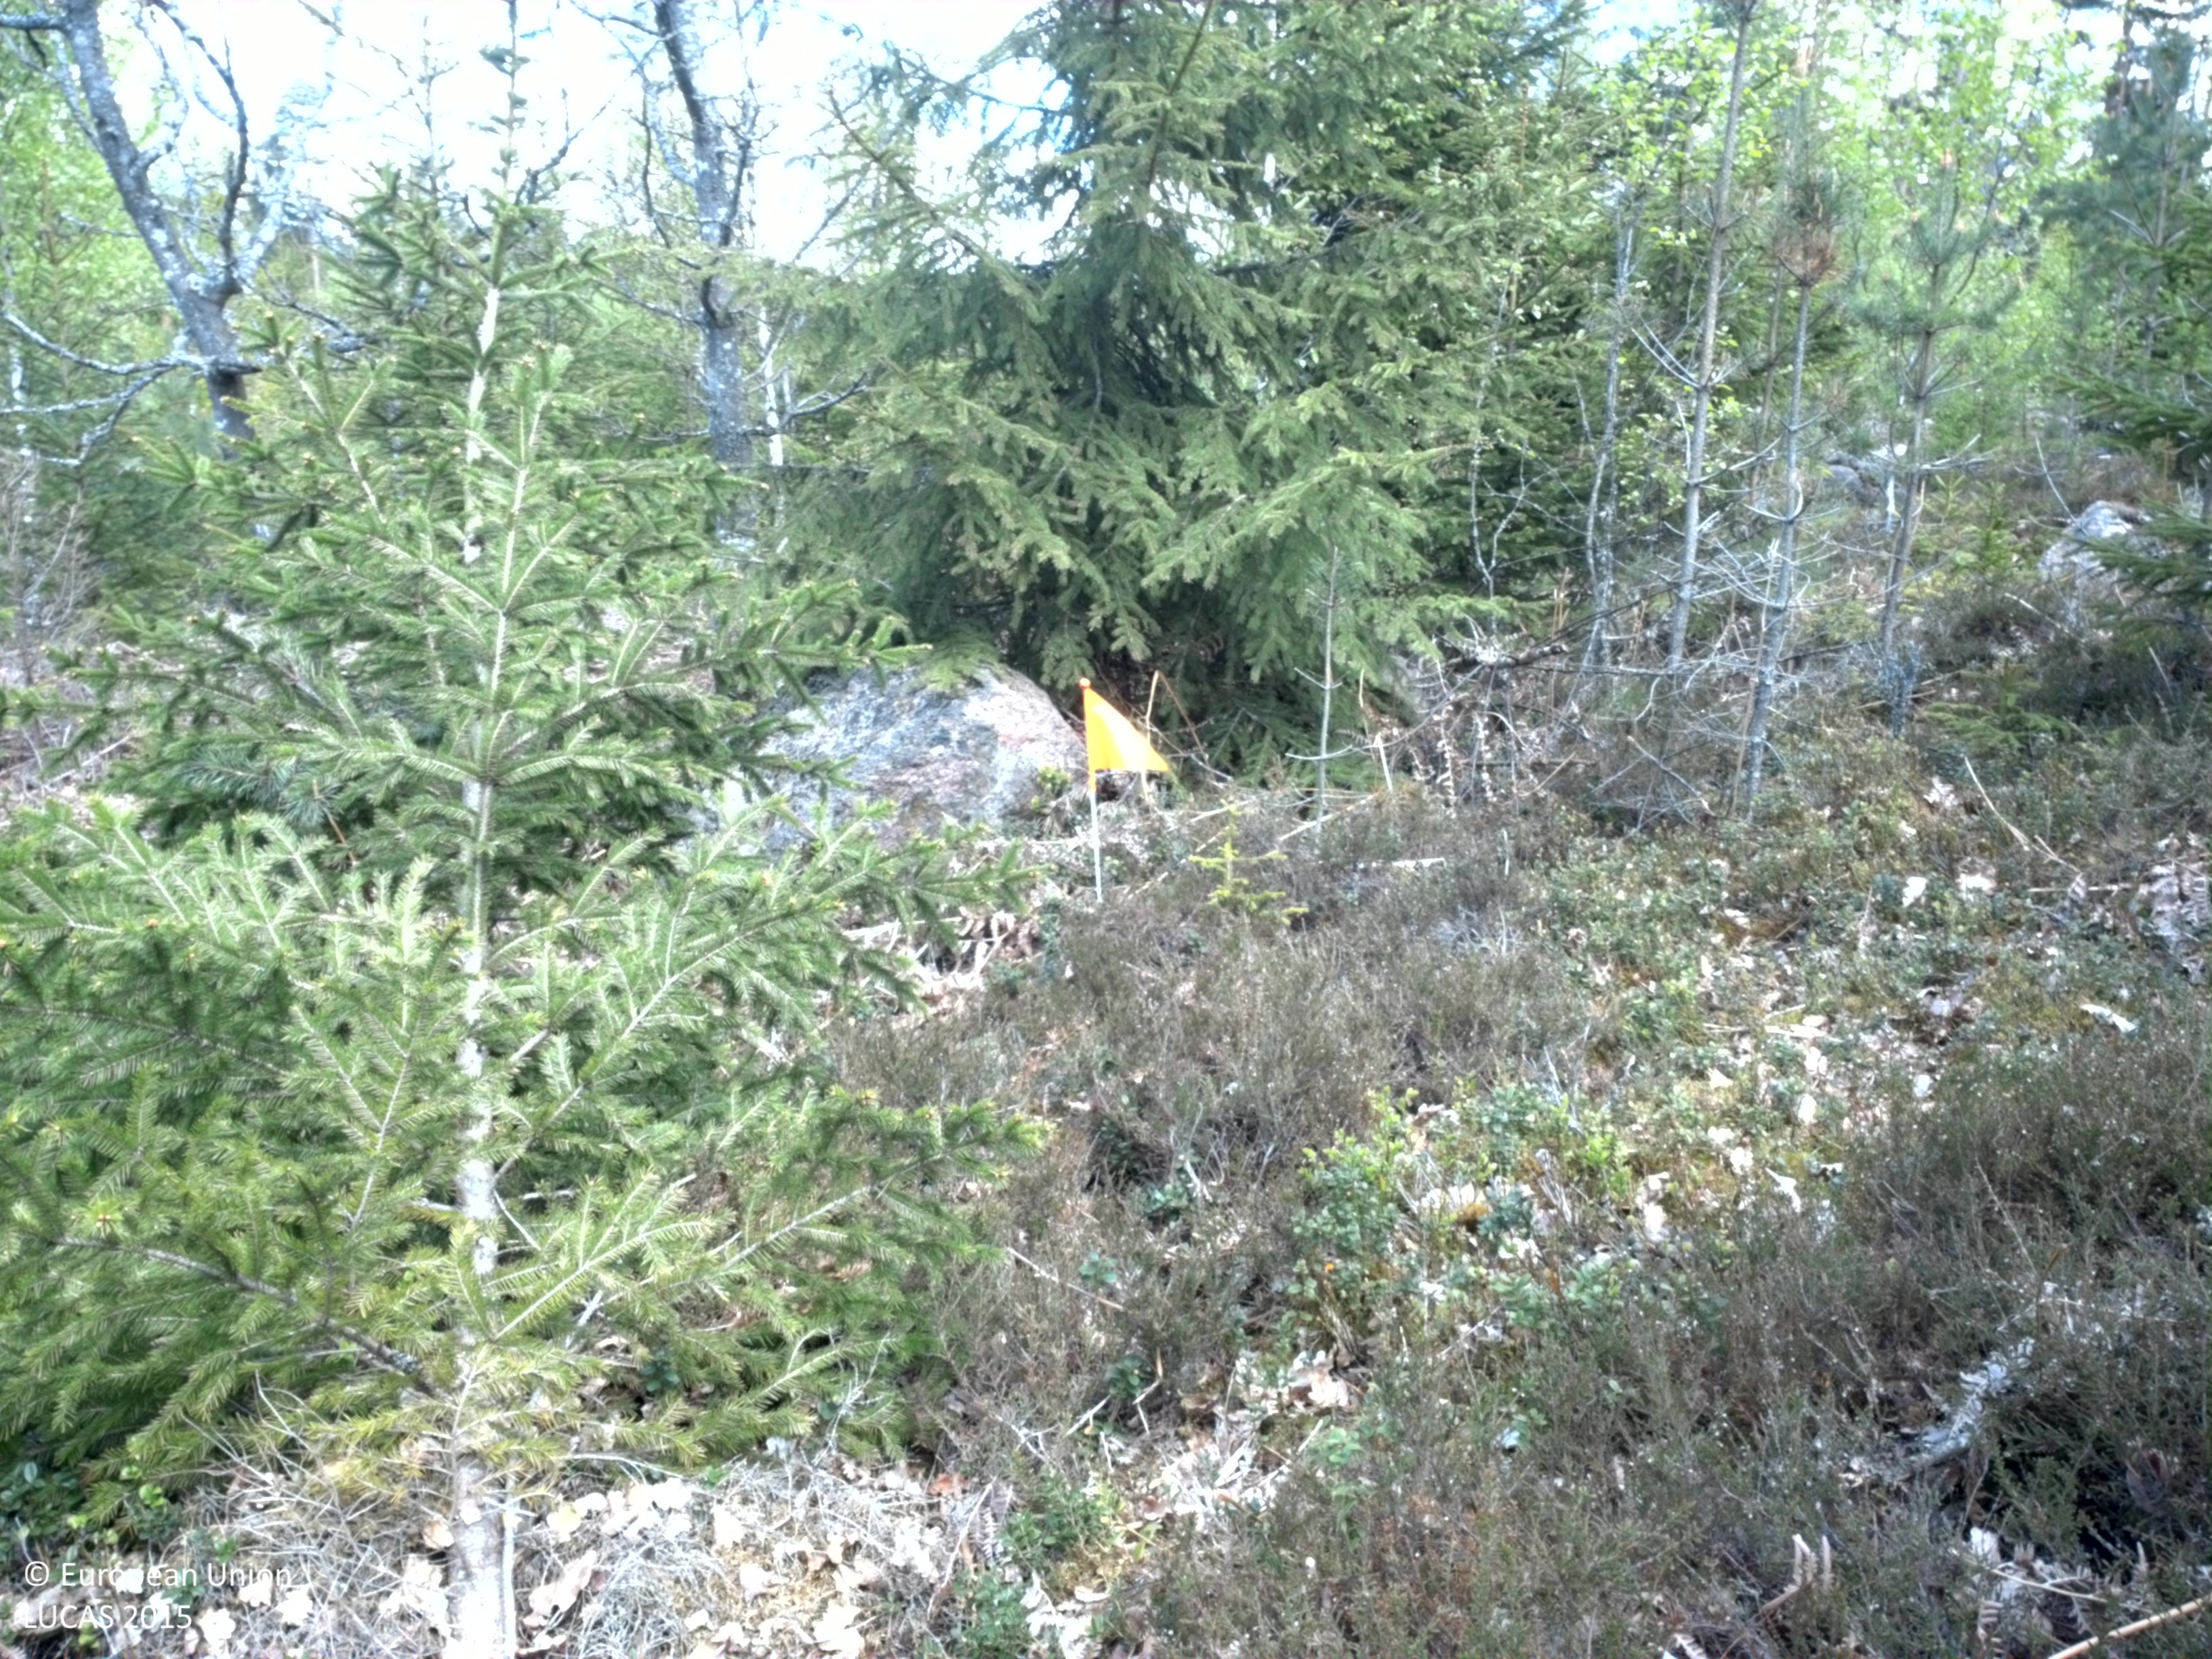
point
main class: Woodland
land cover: Spruce dominated mixed woodland
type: boreal forest
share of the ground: > 75 %
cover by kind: coniferous forest trees 75 %, broadleaved forest trees 25 %
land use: Forestry
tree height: < 5 m
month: May
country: SE
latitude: 56.4539
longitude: 15.3695
